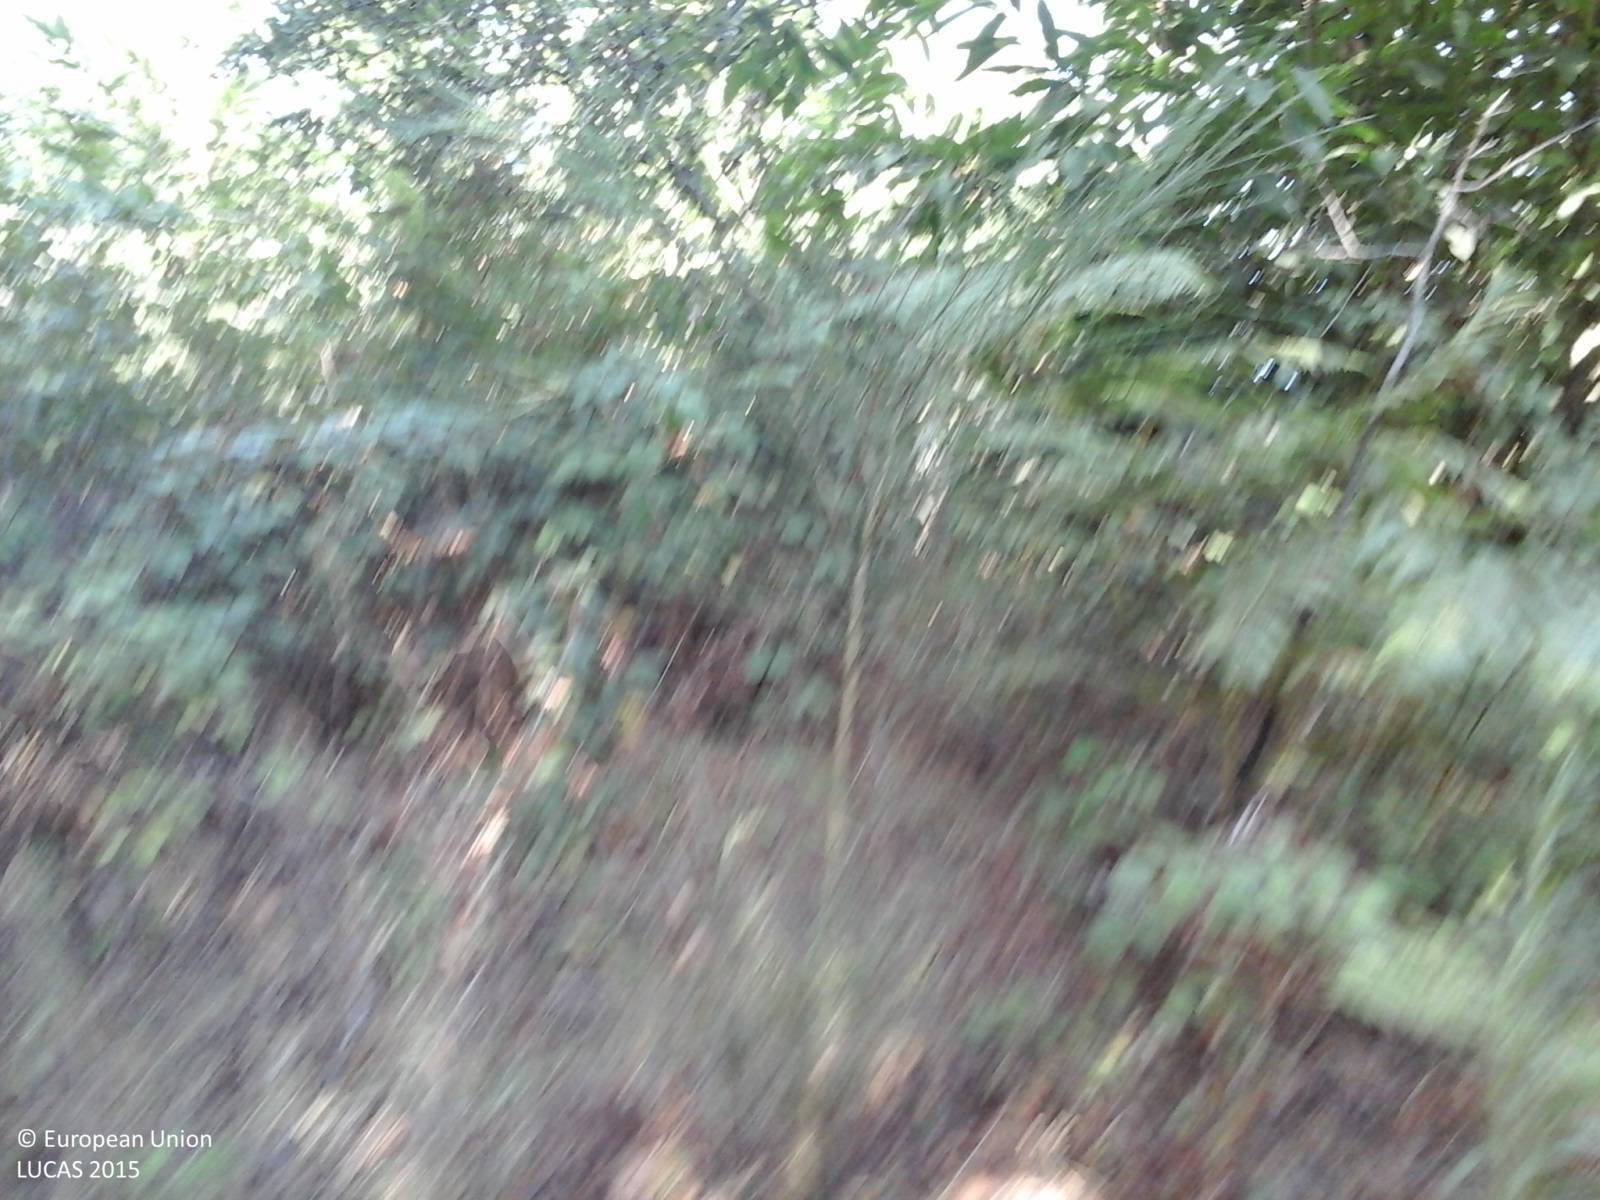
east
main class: Woodland
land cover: Broadleaved woodland
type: thermophilous deciduous forest
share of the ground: > 75 %
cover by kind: broadleaved forest trees 100 %
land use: Forestry
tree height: > 5 m
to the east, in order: Broadleaved woodland
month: August
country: IT
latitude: 42.0724
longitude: 12.0833
